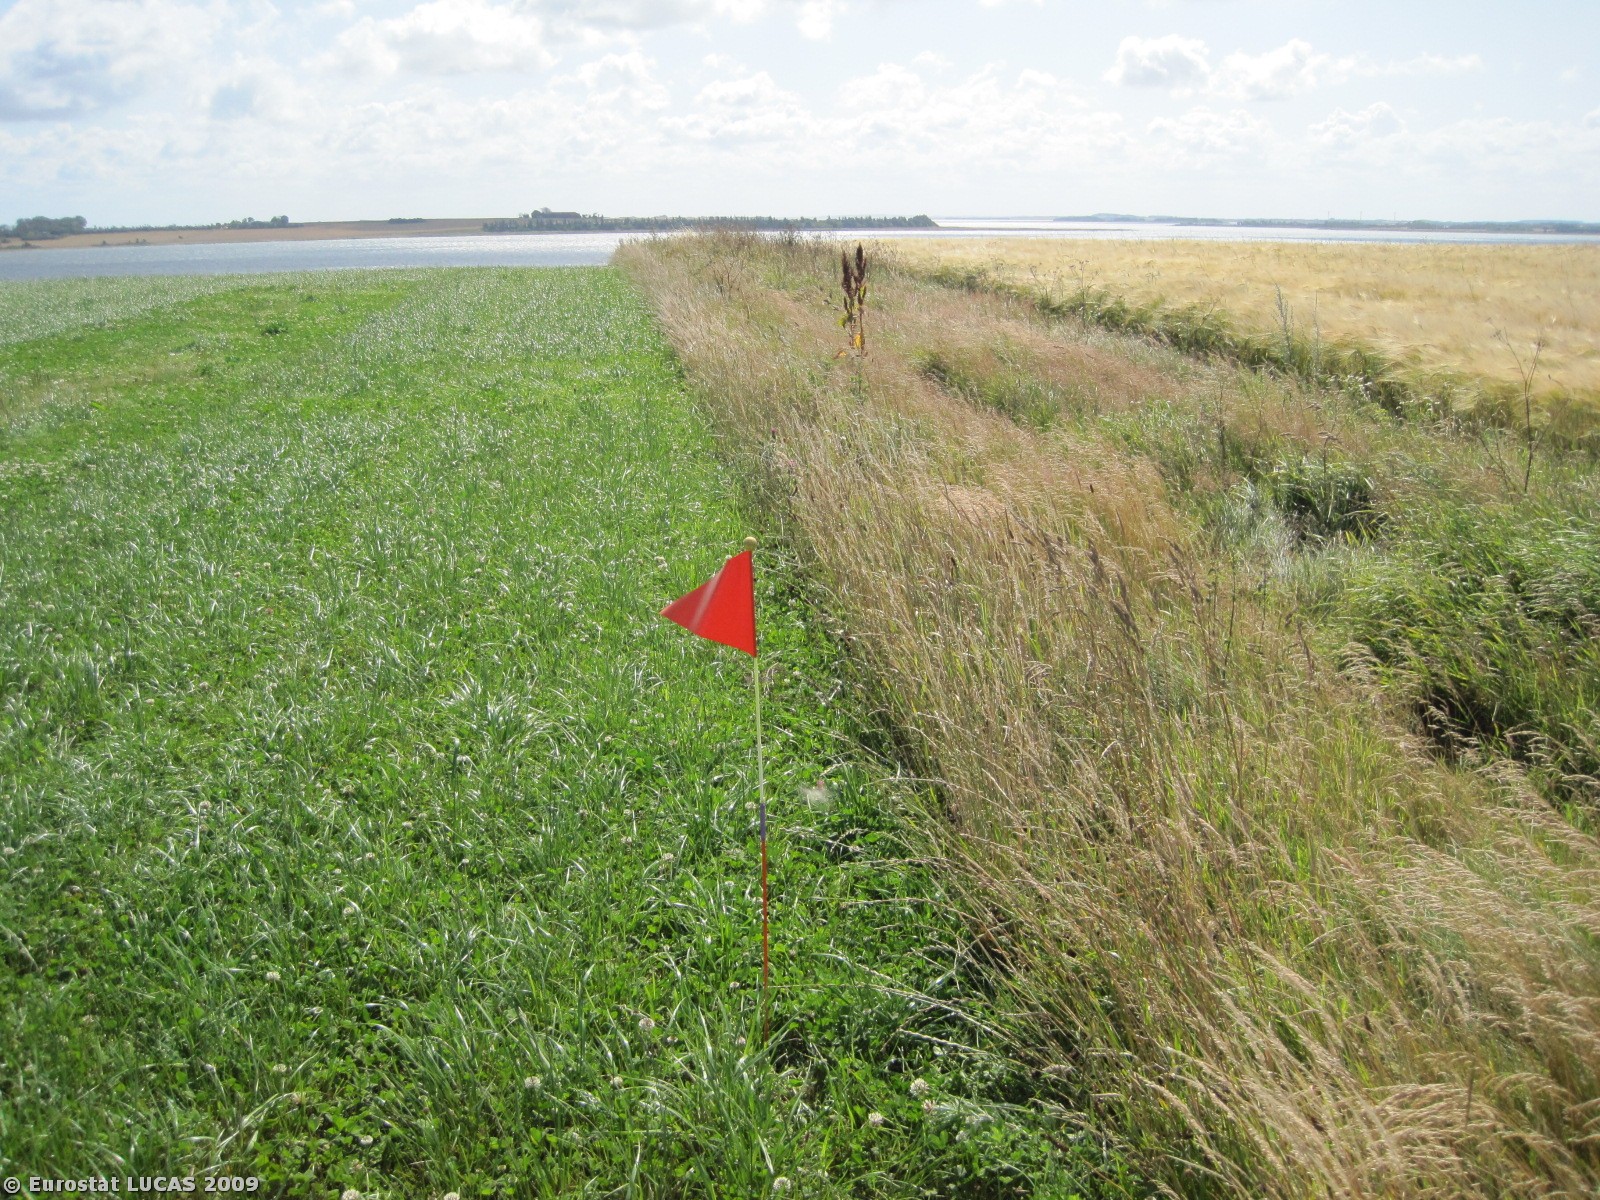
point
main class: Grassland
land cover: Grassland without tree/shrub cover
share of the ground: > 75 %
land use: Agriculture (excluding fallow land and kitchen gardens)
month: July
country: DK
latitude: 56.7362
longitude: 8.4817
